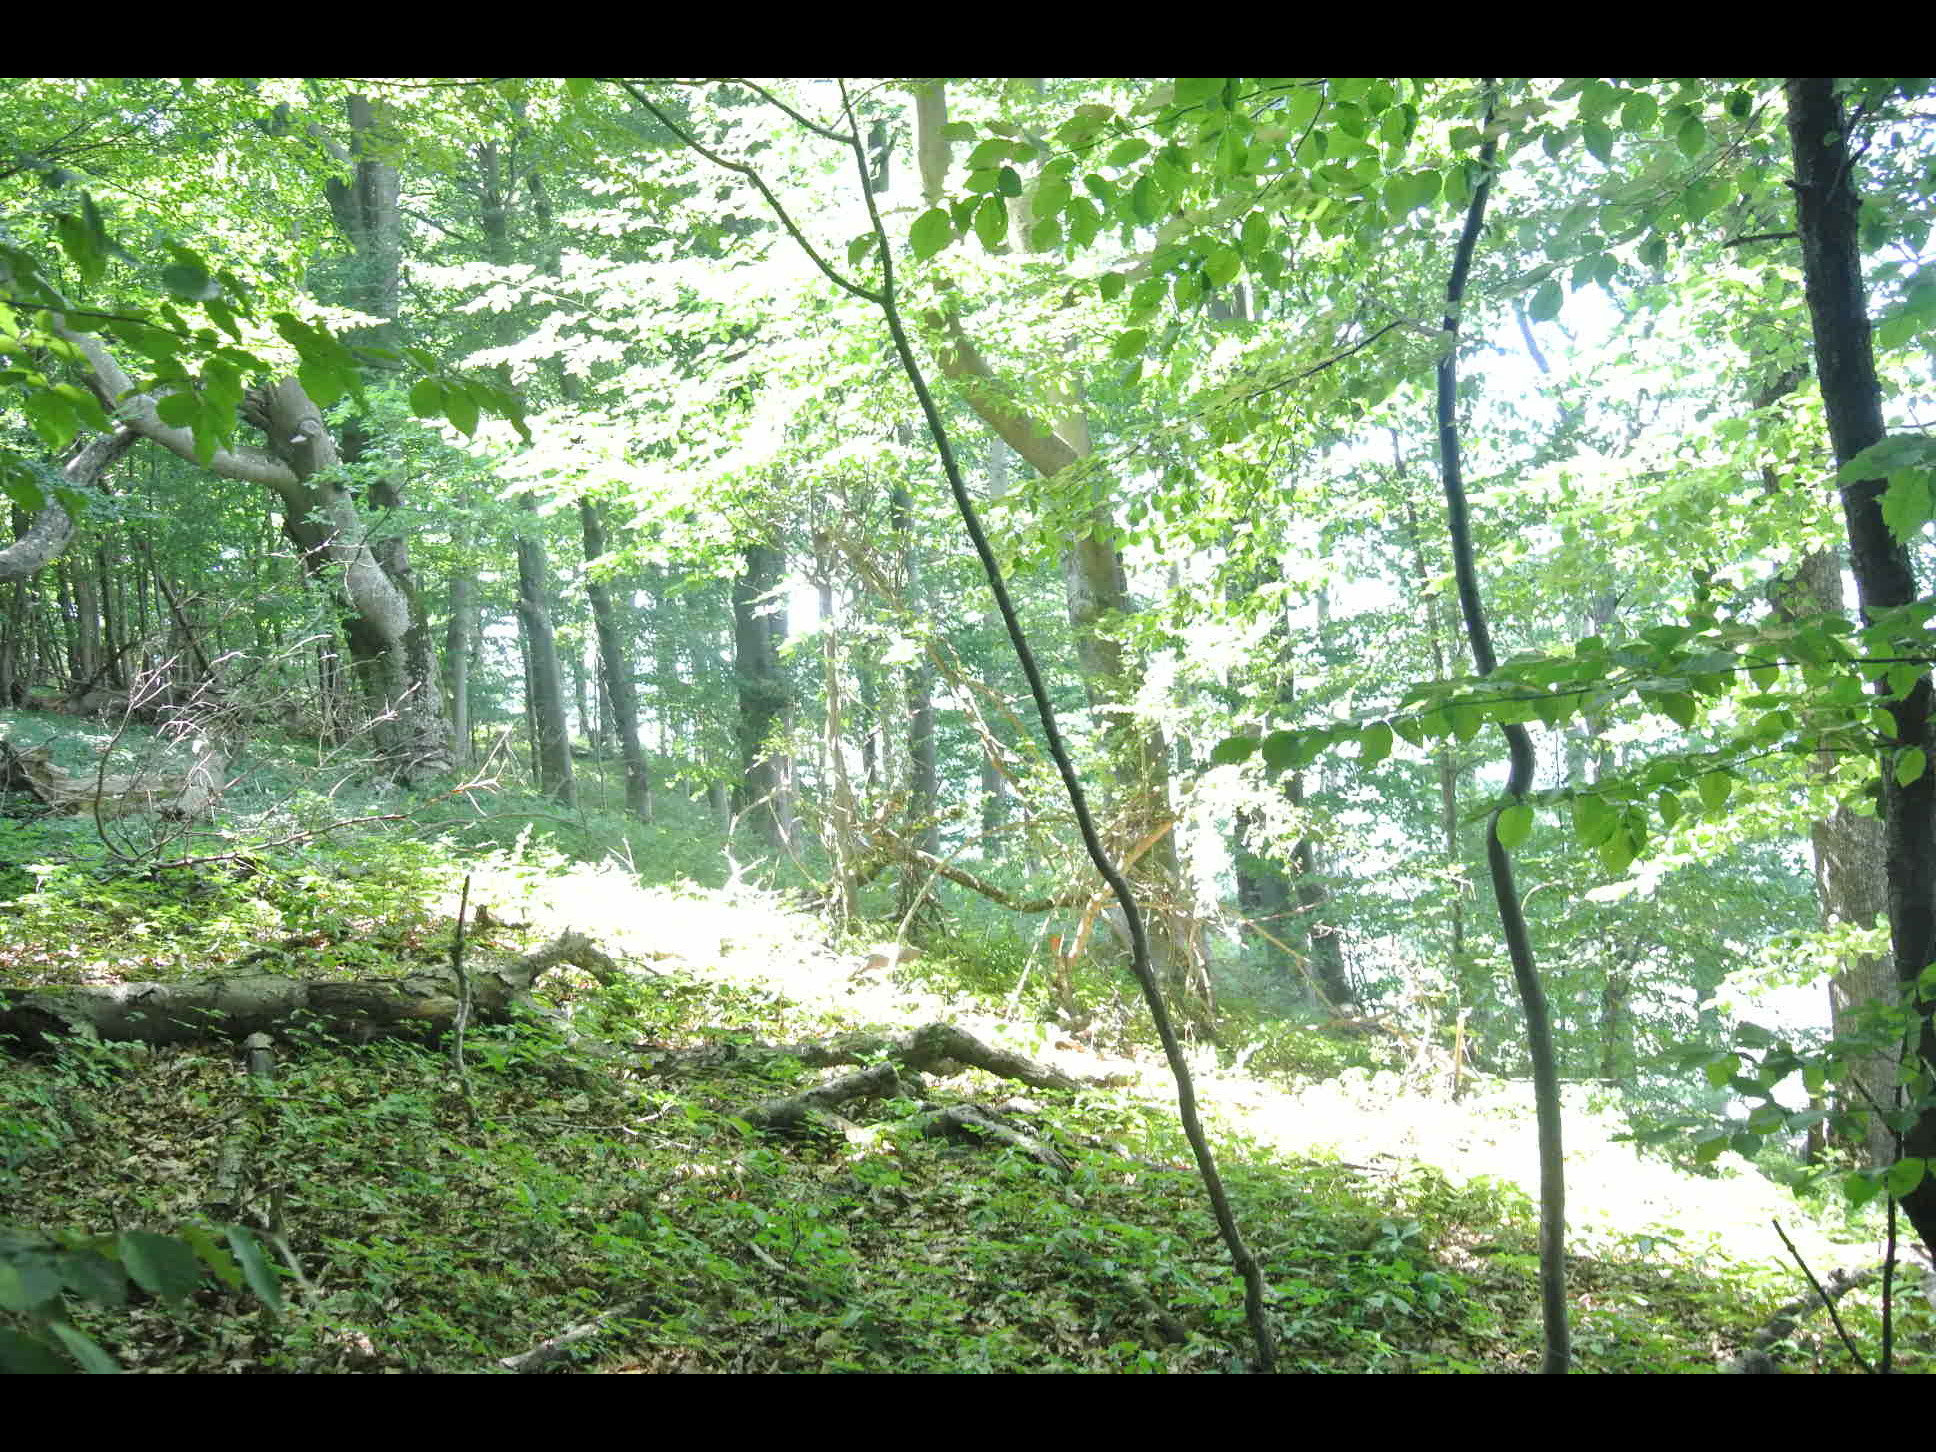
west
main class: Woodland
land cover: Spruce dominated mixed woodland
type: alpine coniferous forest
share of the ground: > 75 %
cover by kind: broadleaved forest trees 70 %, coniferous forest trees 30 %
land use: Forestry
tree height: > 5 m
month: July
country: AT
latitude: 48.0095
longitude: 15.5921
